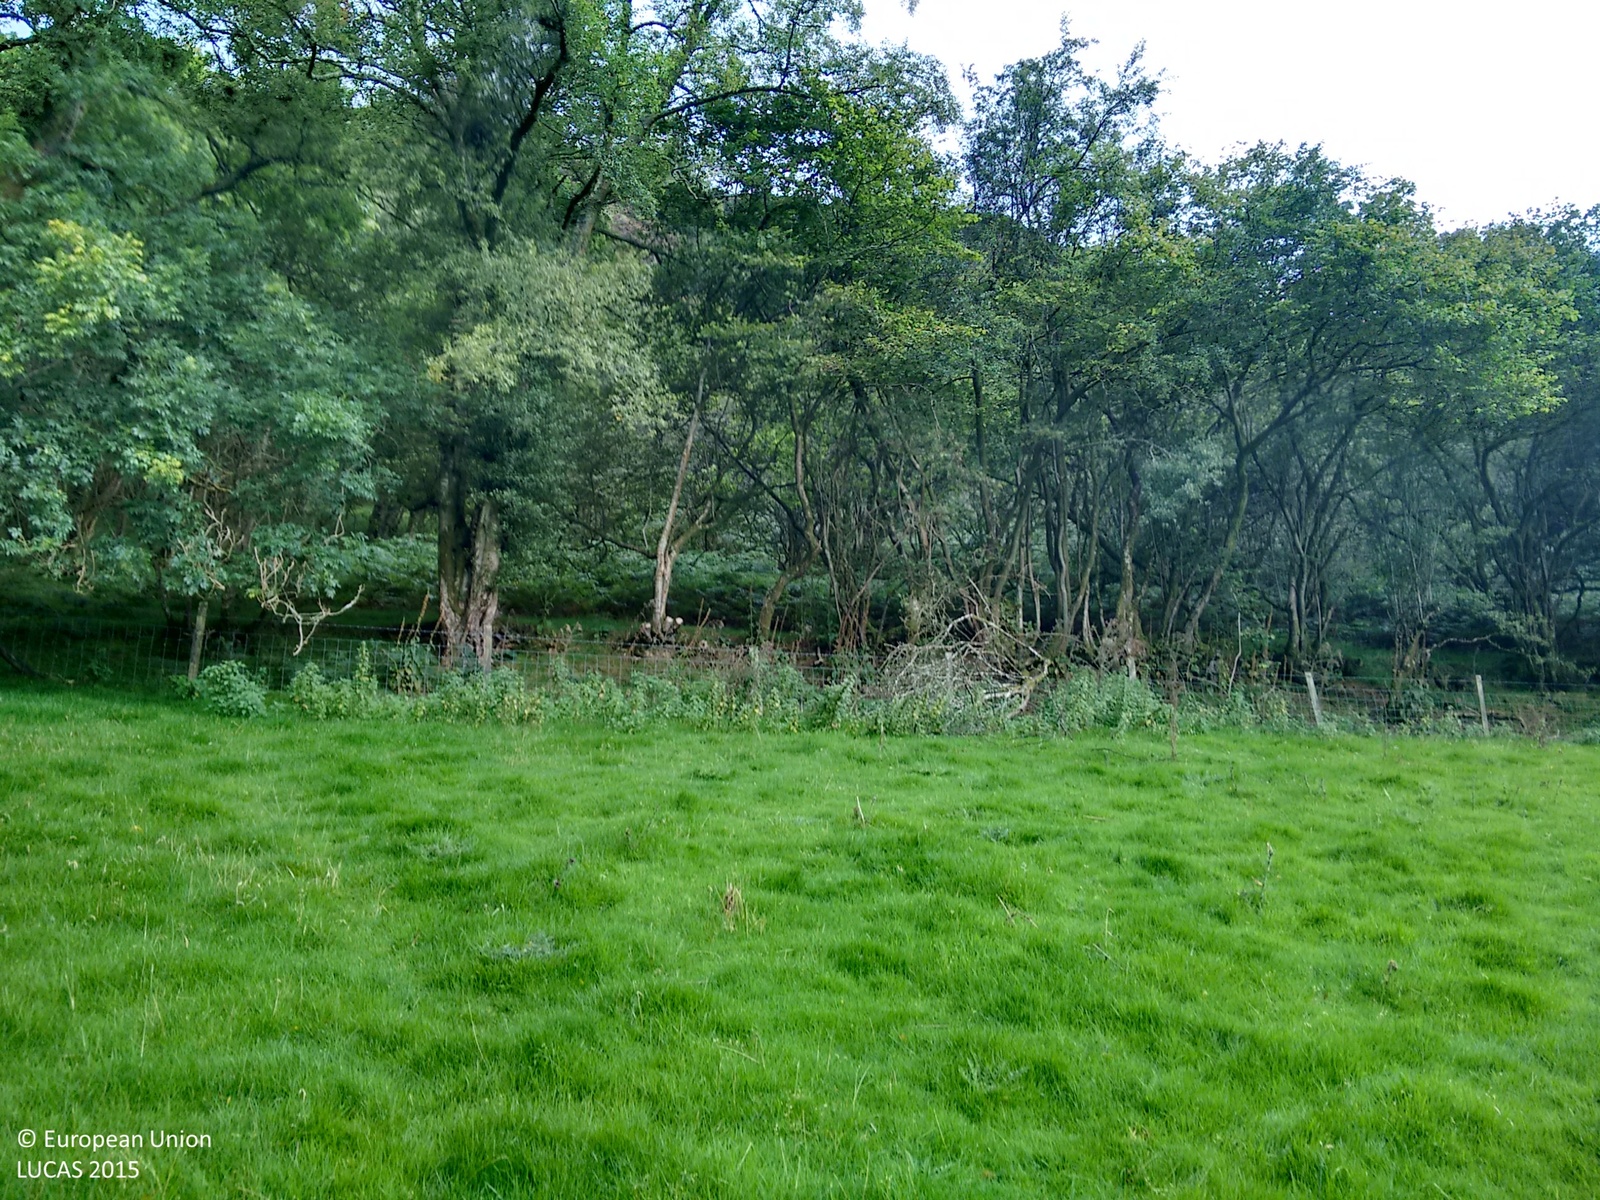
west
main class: Grassland
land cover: Grassland without tree/shrub cover
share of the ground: > 75 %
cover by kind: herbaceous plants 100 %
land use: Agriculture (excluding fallow land and kitchen gardens)
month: September
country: GB
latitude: 52.0926
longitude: -3.8258
